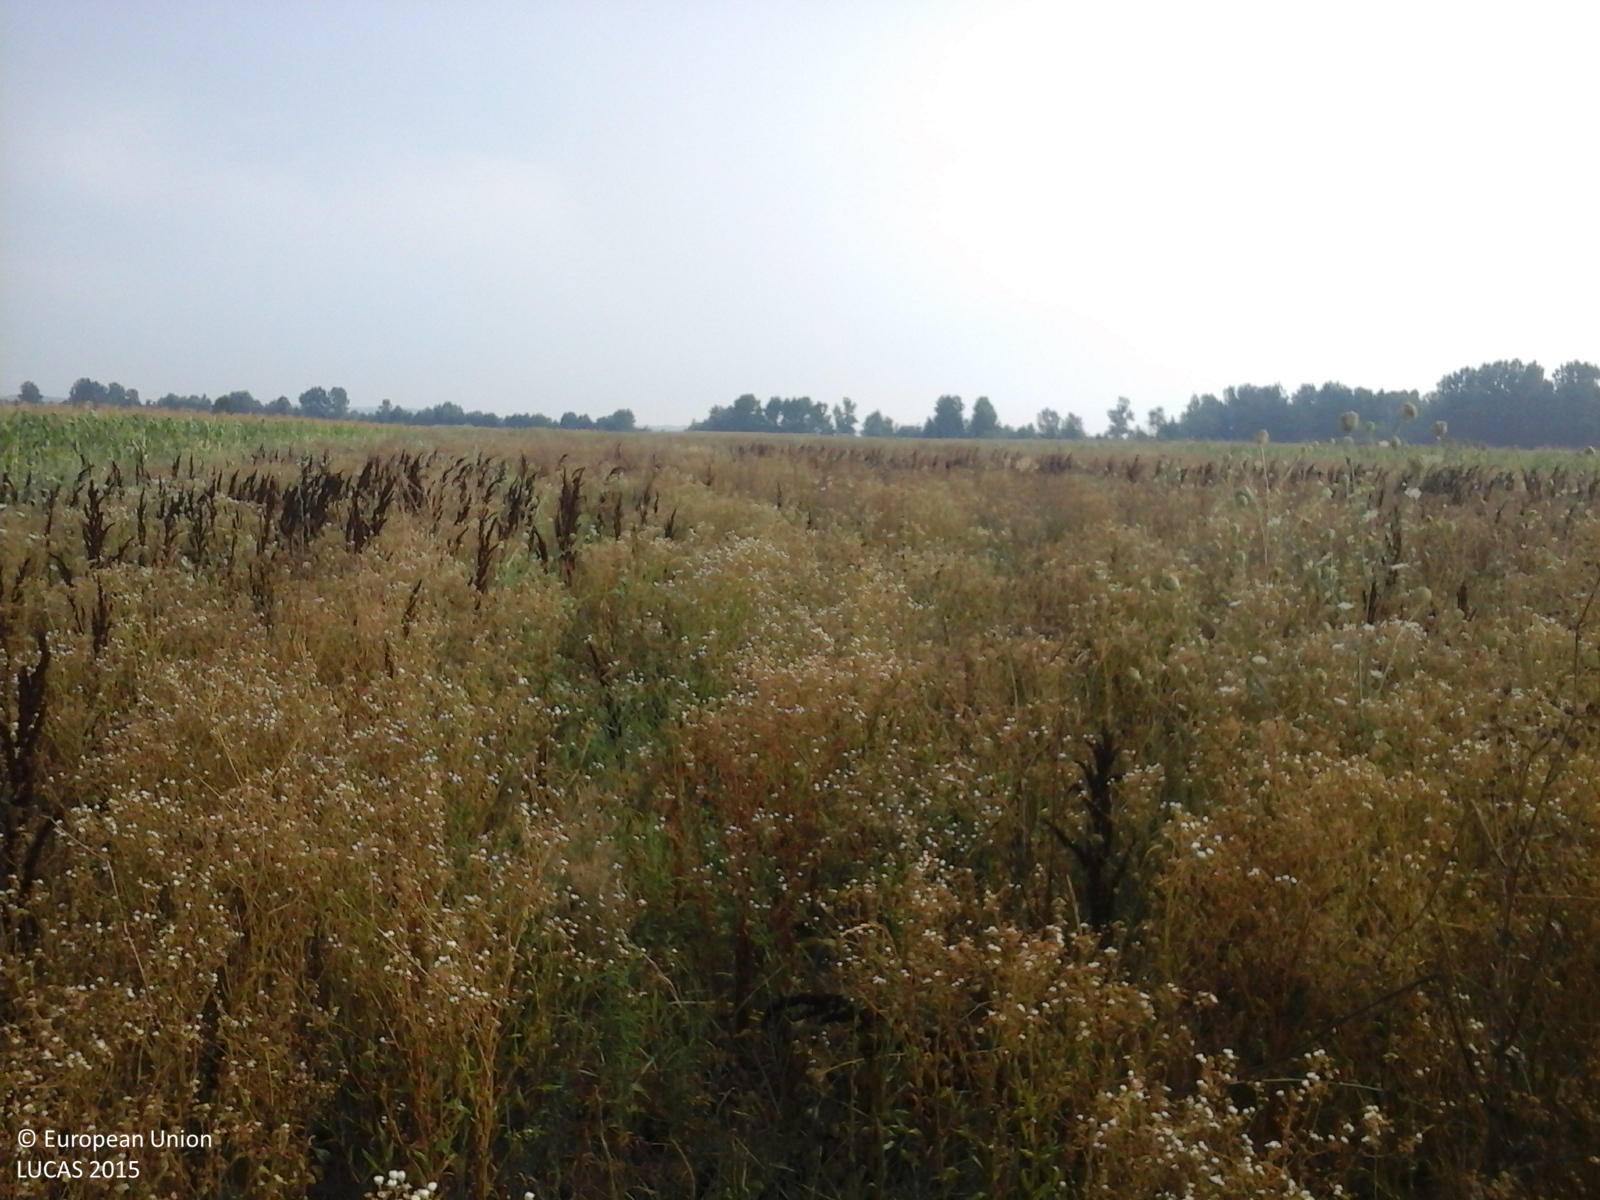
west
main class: Grassland
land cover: Spontaneously vegetated surfaces
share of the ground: > 75 %
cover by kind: herbaceous plants 100 %
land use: Fallow land
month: August
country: RO
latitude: 44.6674
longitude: 23.5131
